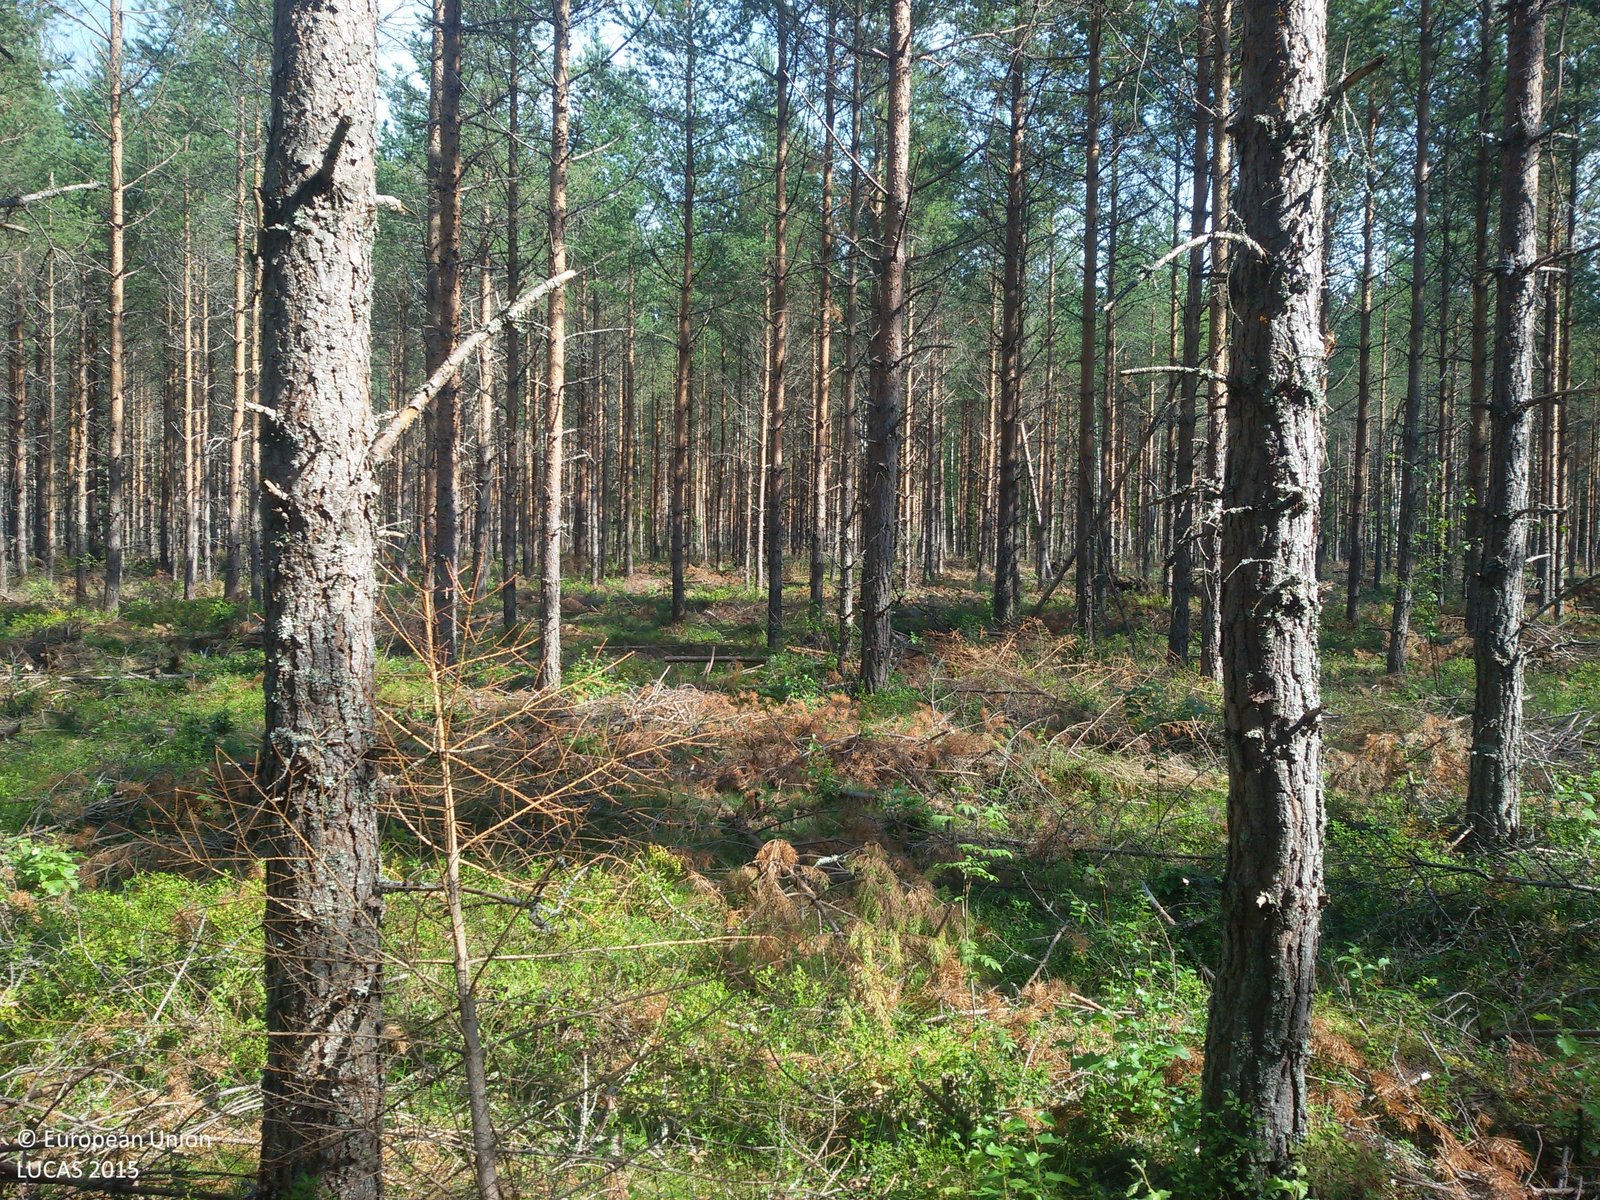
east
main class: Woodland
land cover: Pine dominated coniferous woodland
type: boreal forest
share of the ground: > 75 %
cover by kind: coniferous forest trees 80 %, shrubs 20 %
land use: Forestry
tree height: > 5 m
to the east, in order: Pine dominated coniferous woodland; Tracks; Pine dominated coniferous woodland; Tracks; Pine dominated coniferous woodland; Tracks; Pine dominated coniferous woodland; Tracks; Pine dominated coniferous woodland; Tracks; Pine dominated coniferous woodland
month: August
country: SE
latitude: 60.4800
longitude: 16.5569
